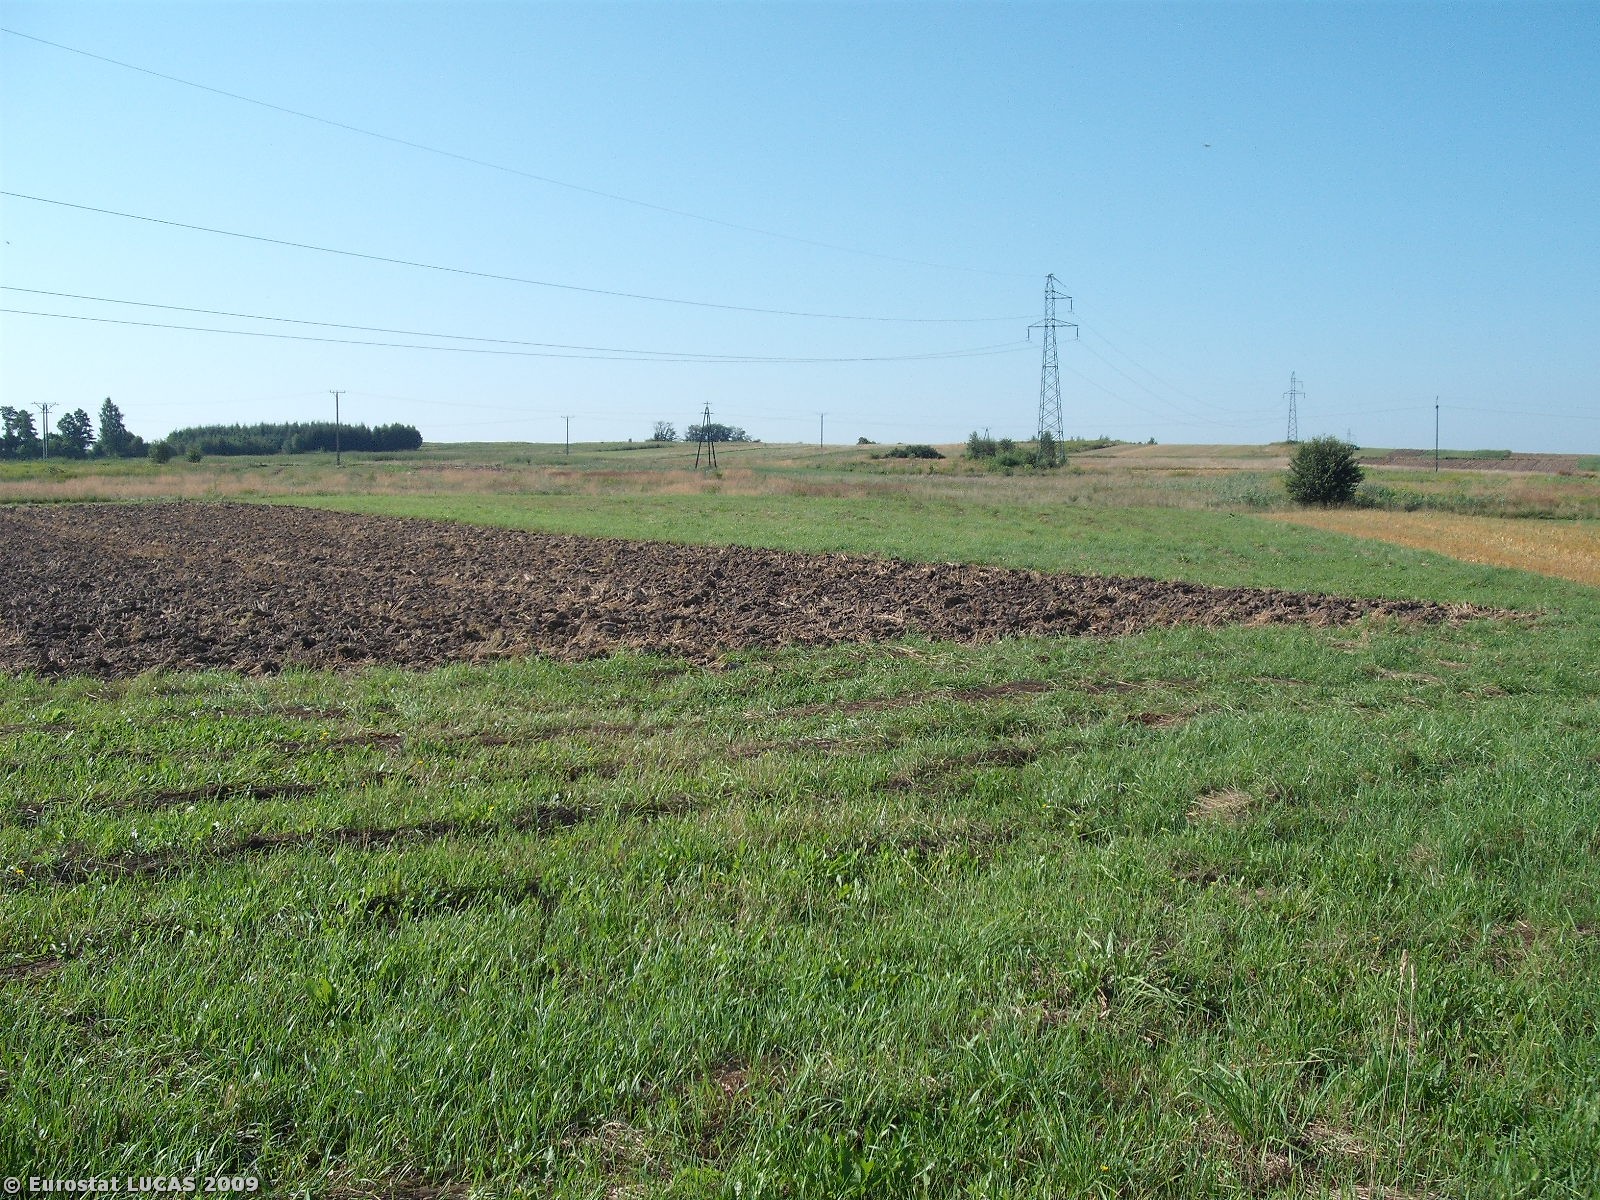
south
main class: Grassland
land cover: Grassland without tree/shrub cover
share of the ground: > 75 %
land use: Agriculture (excluding fallow land and kitchen gardens)
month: August
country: PL
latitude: 50.1572
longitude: 22.0822
